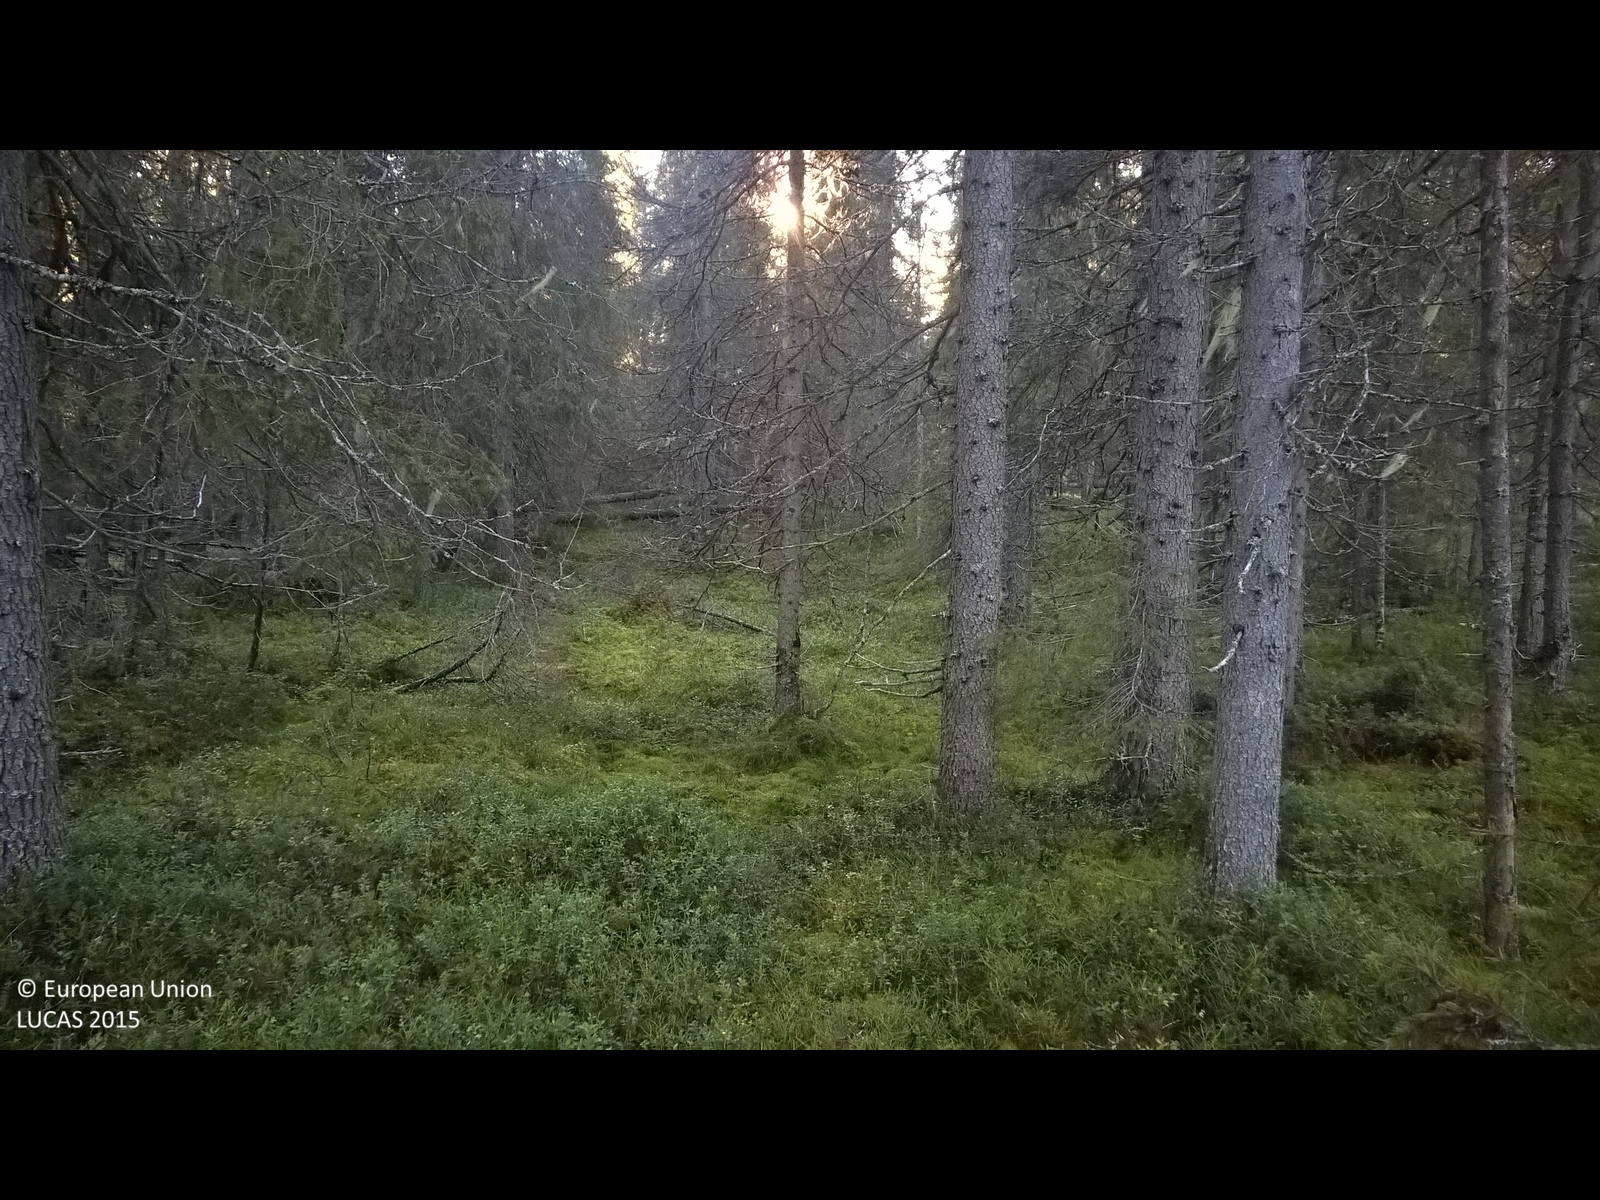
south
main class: Woodland
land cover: Spruce dominated coniferous woodland
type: boreal forest
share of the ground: > 75 %
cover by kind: coniferous forest trees 75 %, shrubs 20 %, herbaceous plants 5 %
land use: Forestry
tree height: > 5 m
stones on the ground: < 10 %
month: October
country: SE
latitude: 65.3684
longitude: 18.5410
